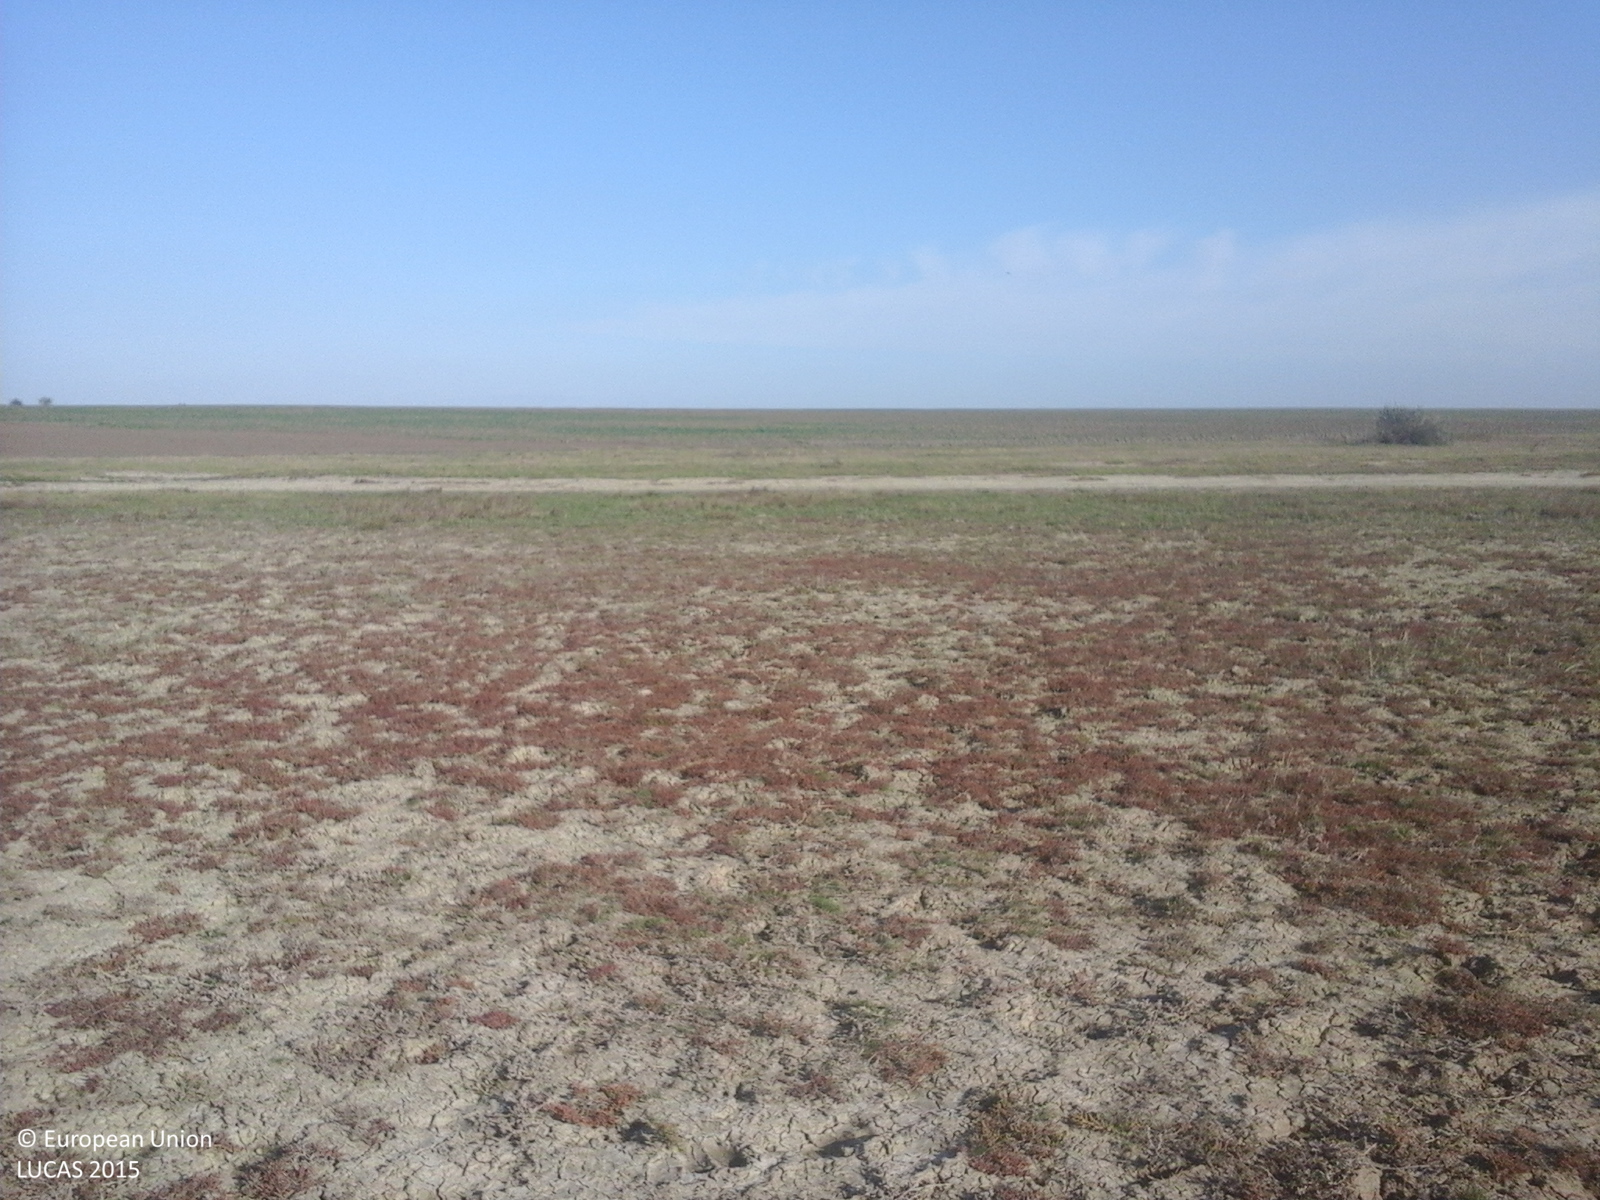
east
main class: Grassland
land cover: Grassland without tree/shrub cover
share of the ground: > 75 %
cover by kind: herbaceous plants 100 %
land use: Agriculture (excluding fallow land and kitchen gardens)
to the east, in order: Grassland without tree/shrub cover; Tracks; Grassland without tree/shrub cover; Tracks; Common wheat
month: October
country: RO
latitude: 45.2181
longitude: 27.3241
